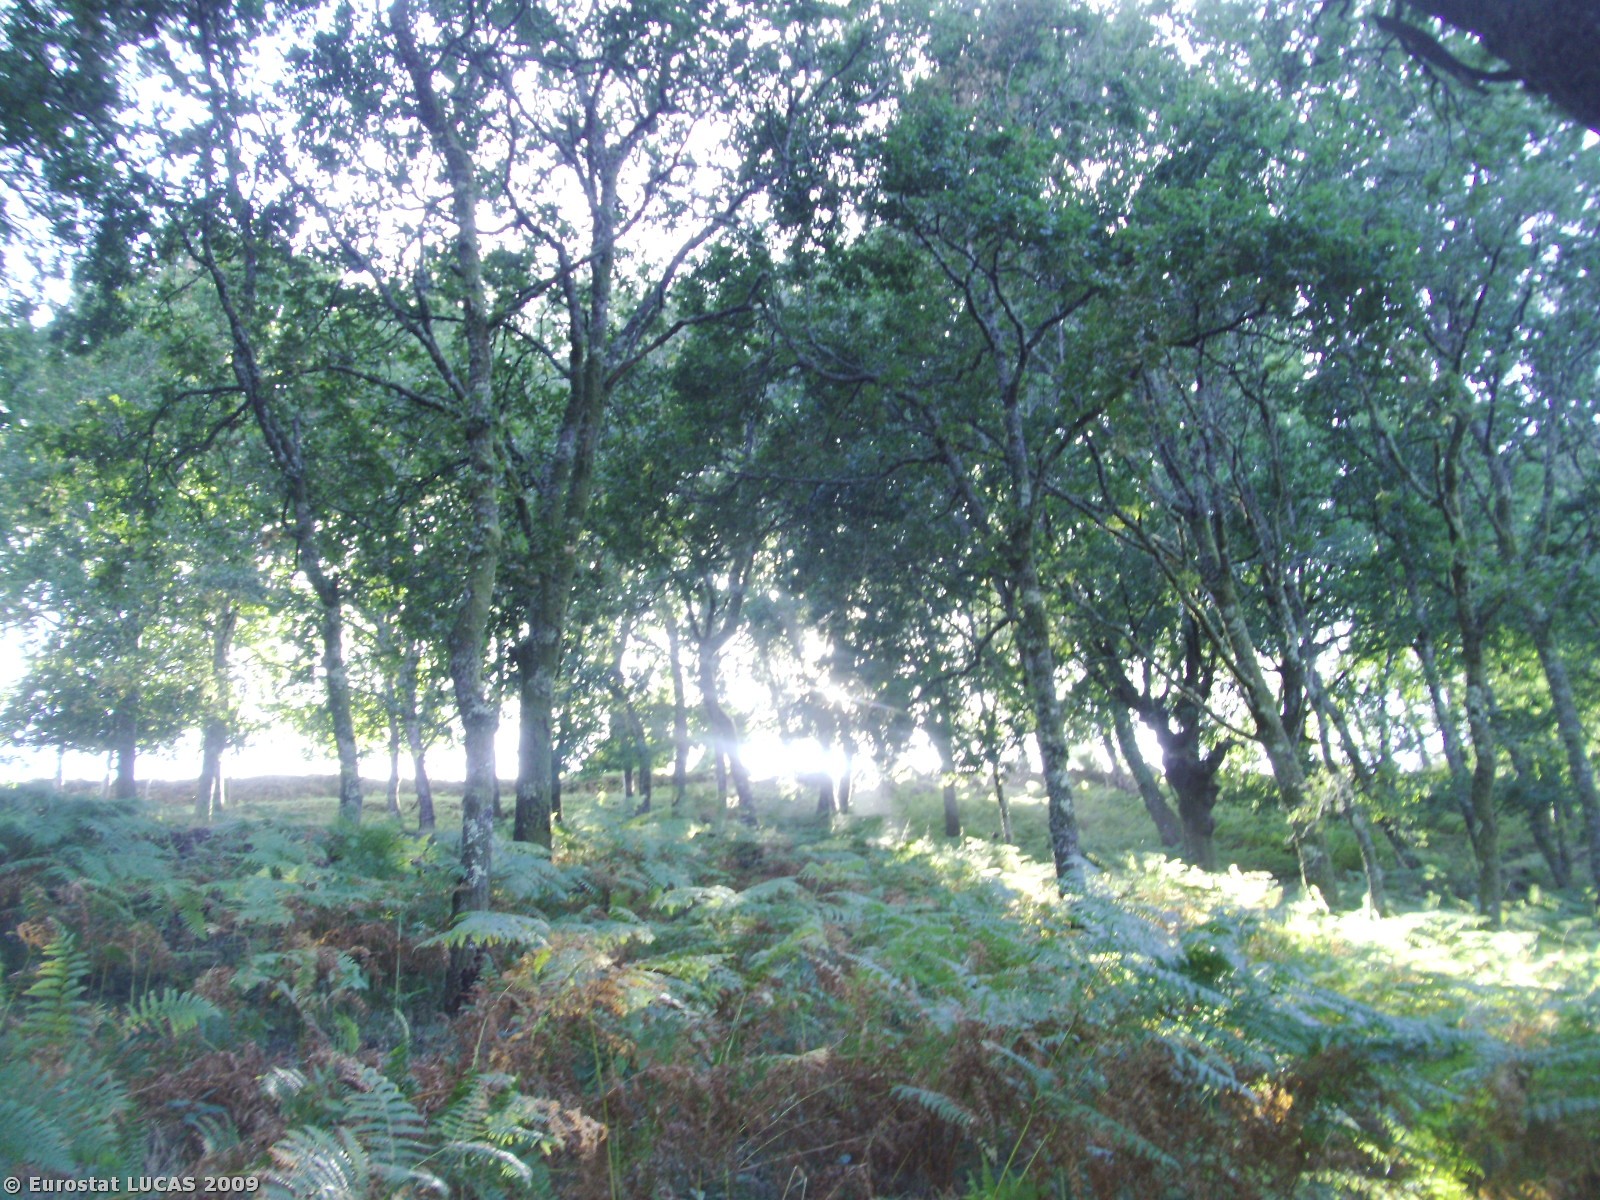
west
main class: Woodland
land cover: Broadleaved woodland
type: acidophilous oak and oak-birch forest
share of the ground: > 75 %
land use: Forestry
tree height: > 5 m
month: September
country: PT
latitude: 41.6667
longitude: -8.0276
